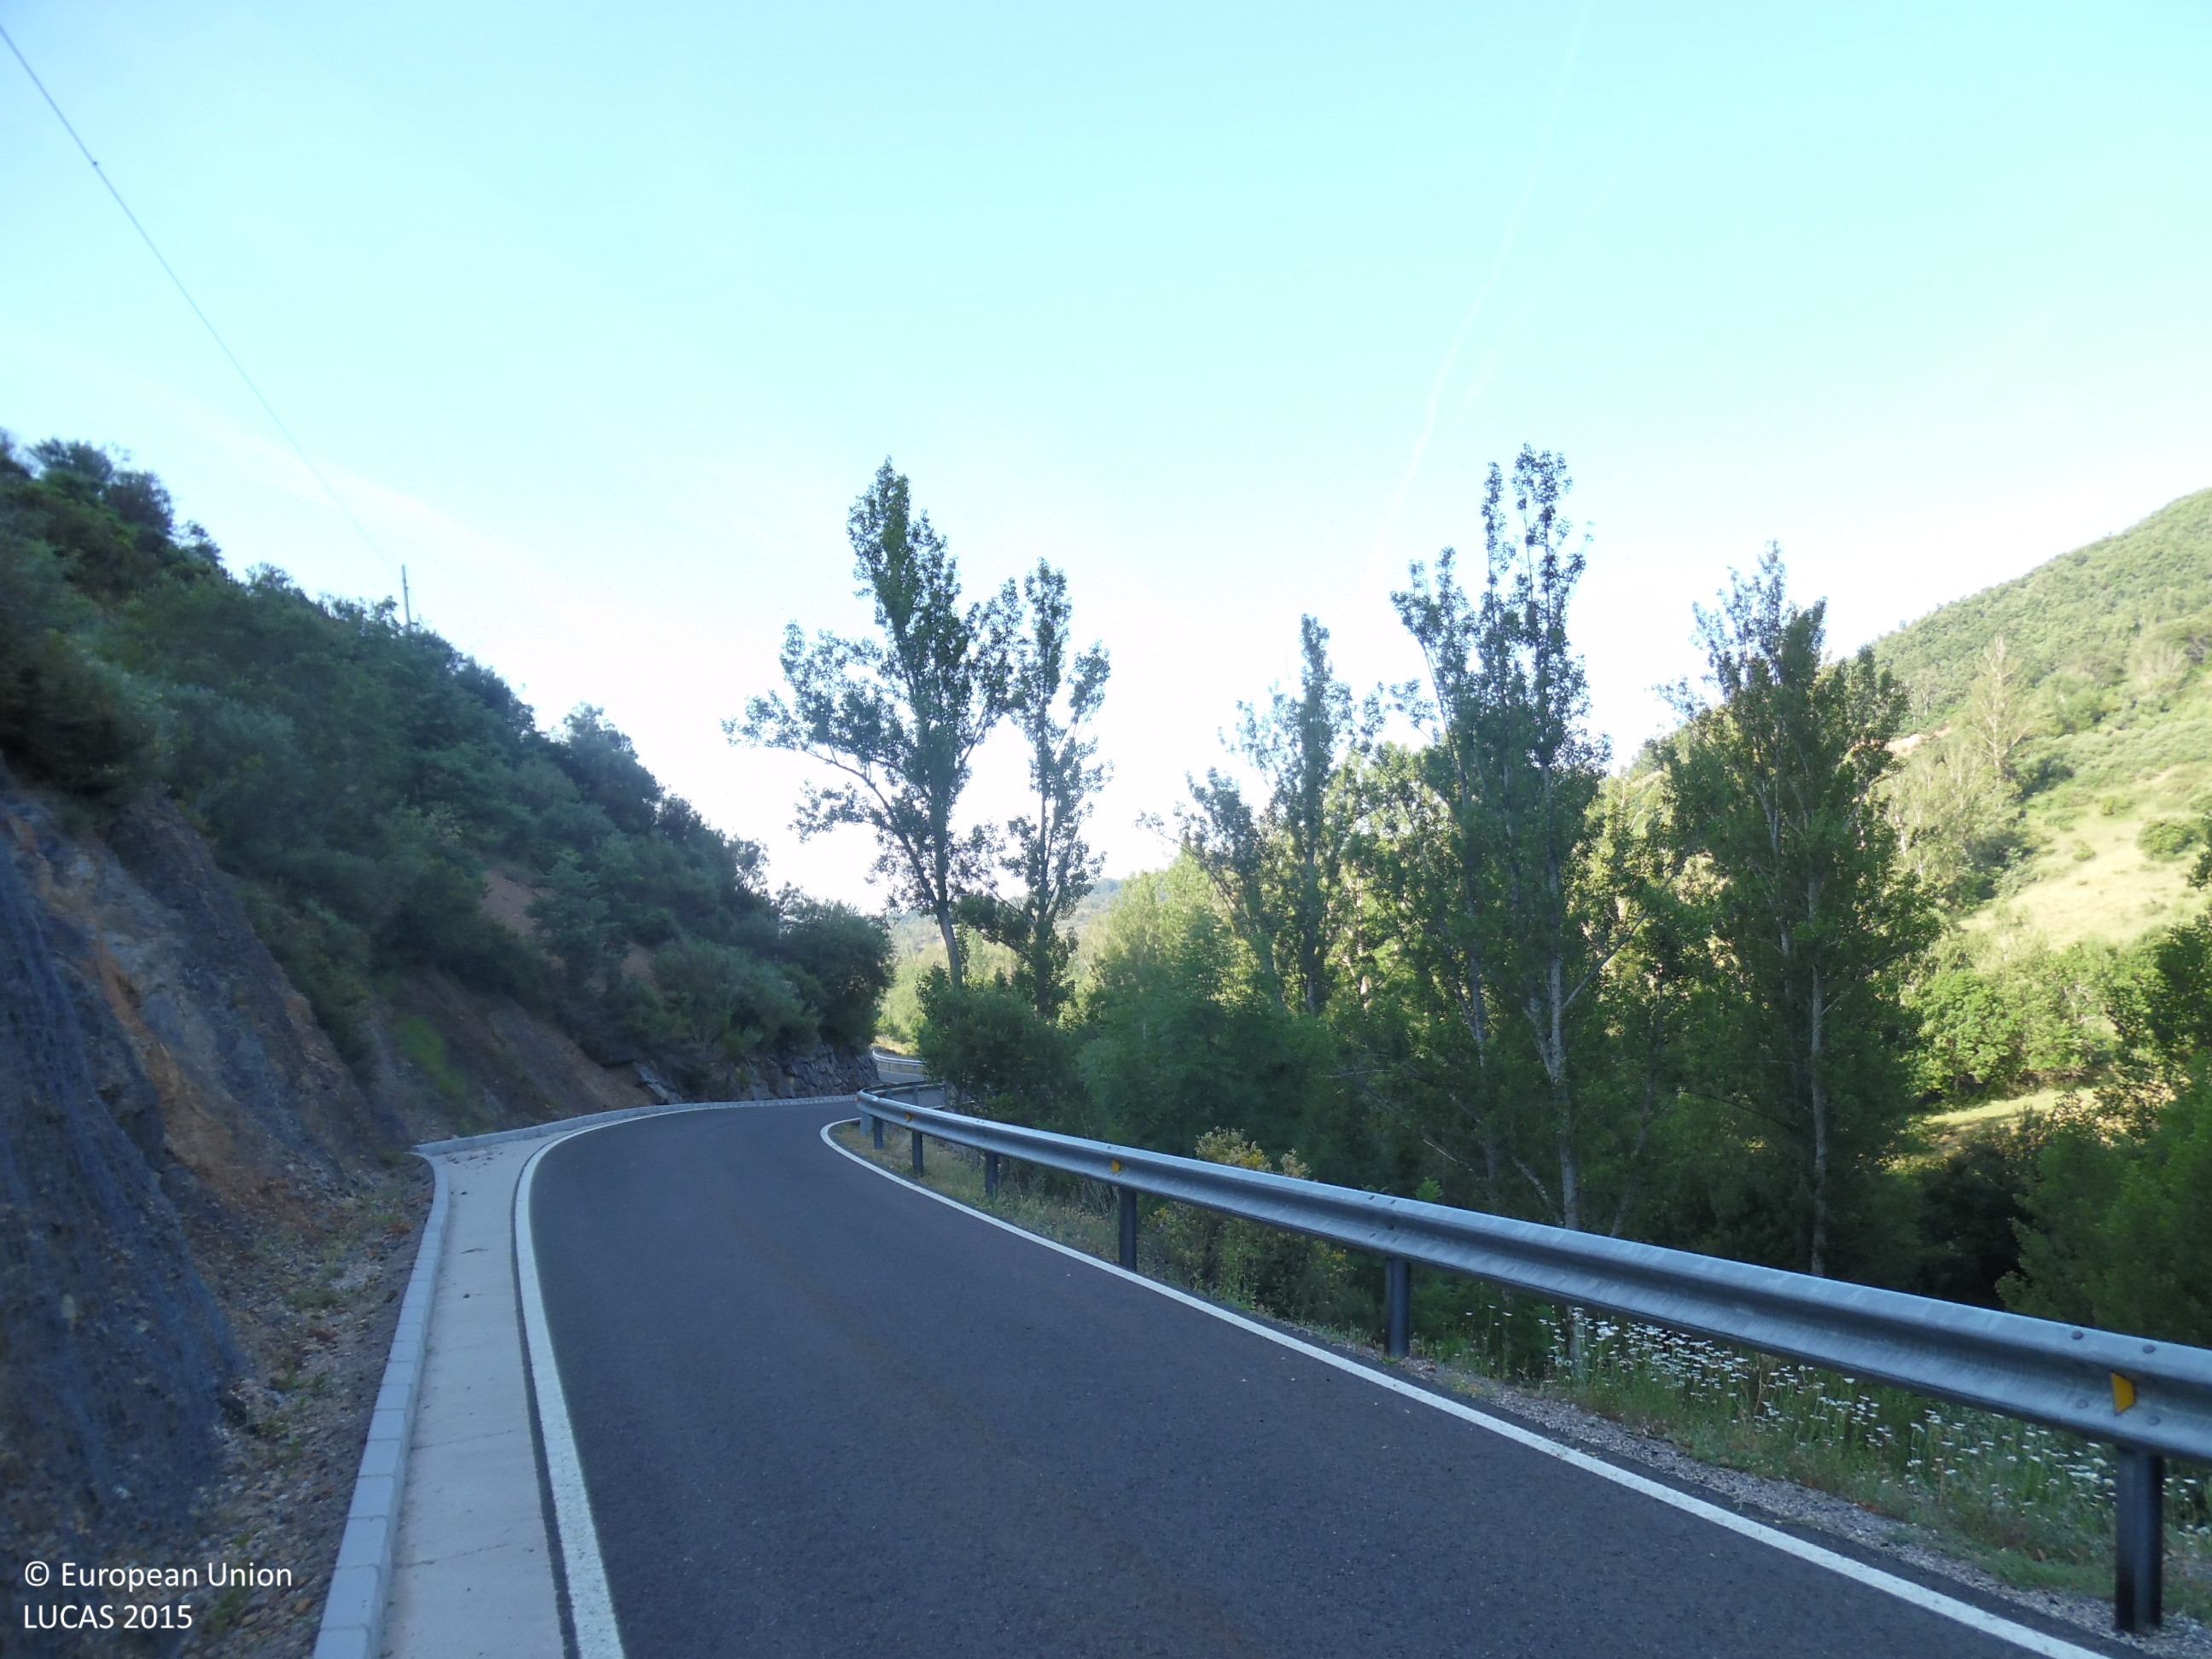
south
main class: Shrubland
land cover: Shrubland with sparse tree cover
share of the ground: > 75 %
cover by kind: shrubs 85 %, unconsolidated bare surface 10 %, broadleaved forest trees 5 %
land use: Abandoned areas
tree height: < 5 m
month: June
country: ES
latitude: 42.8054
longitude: -5.7683
